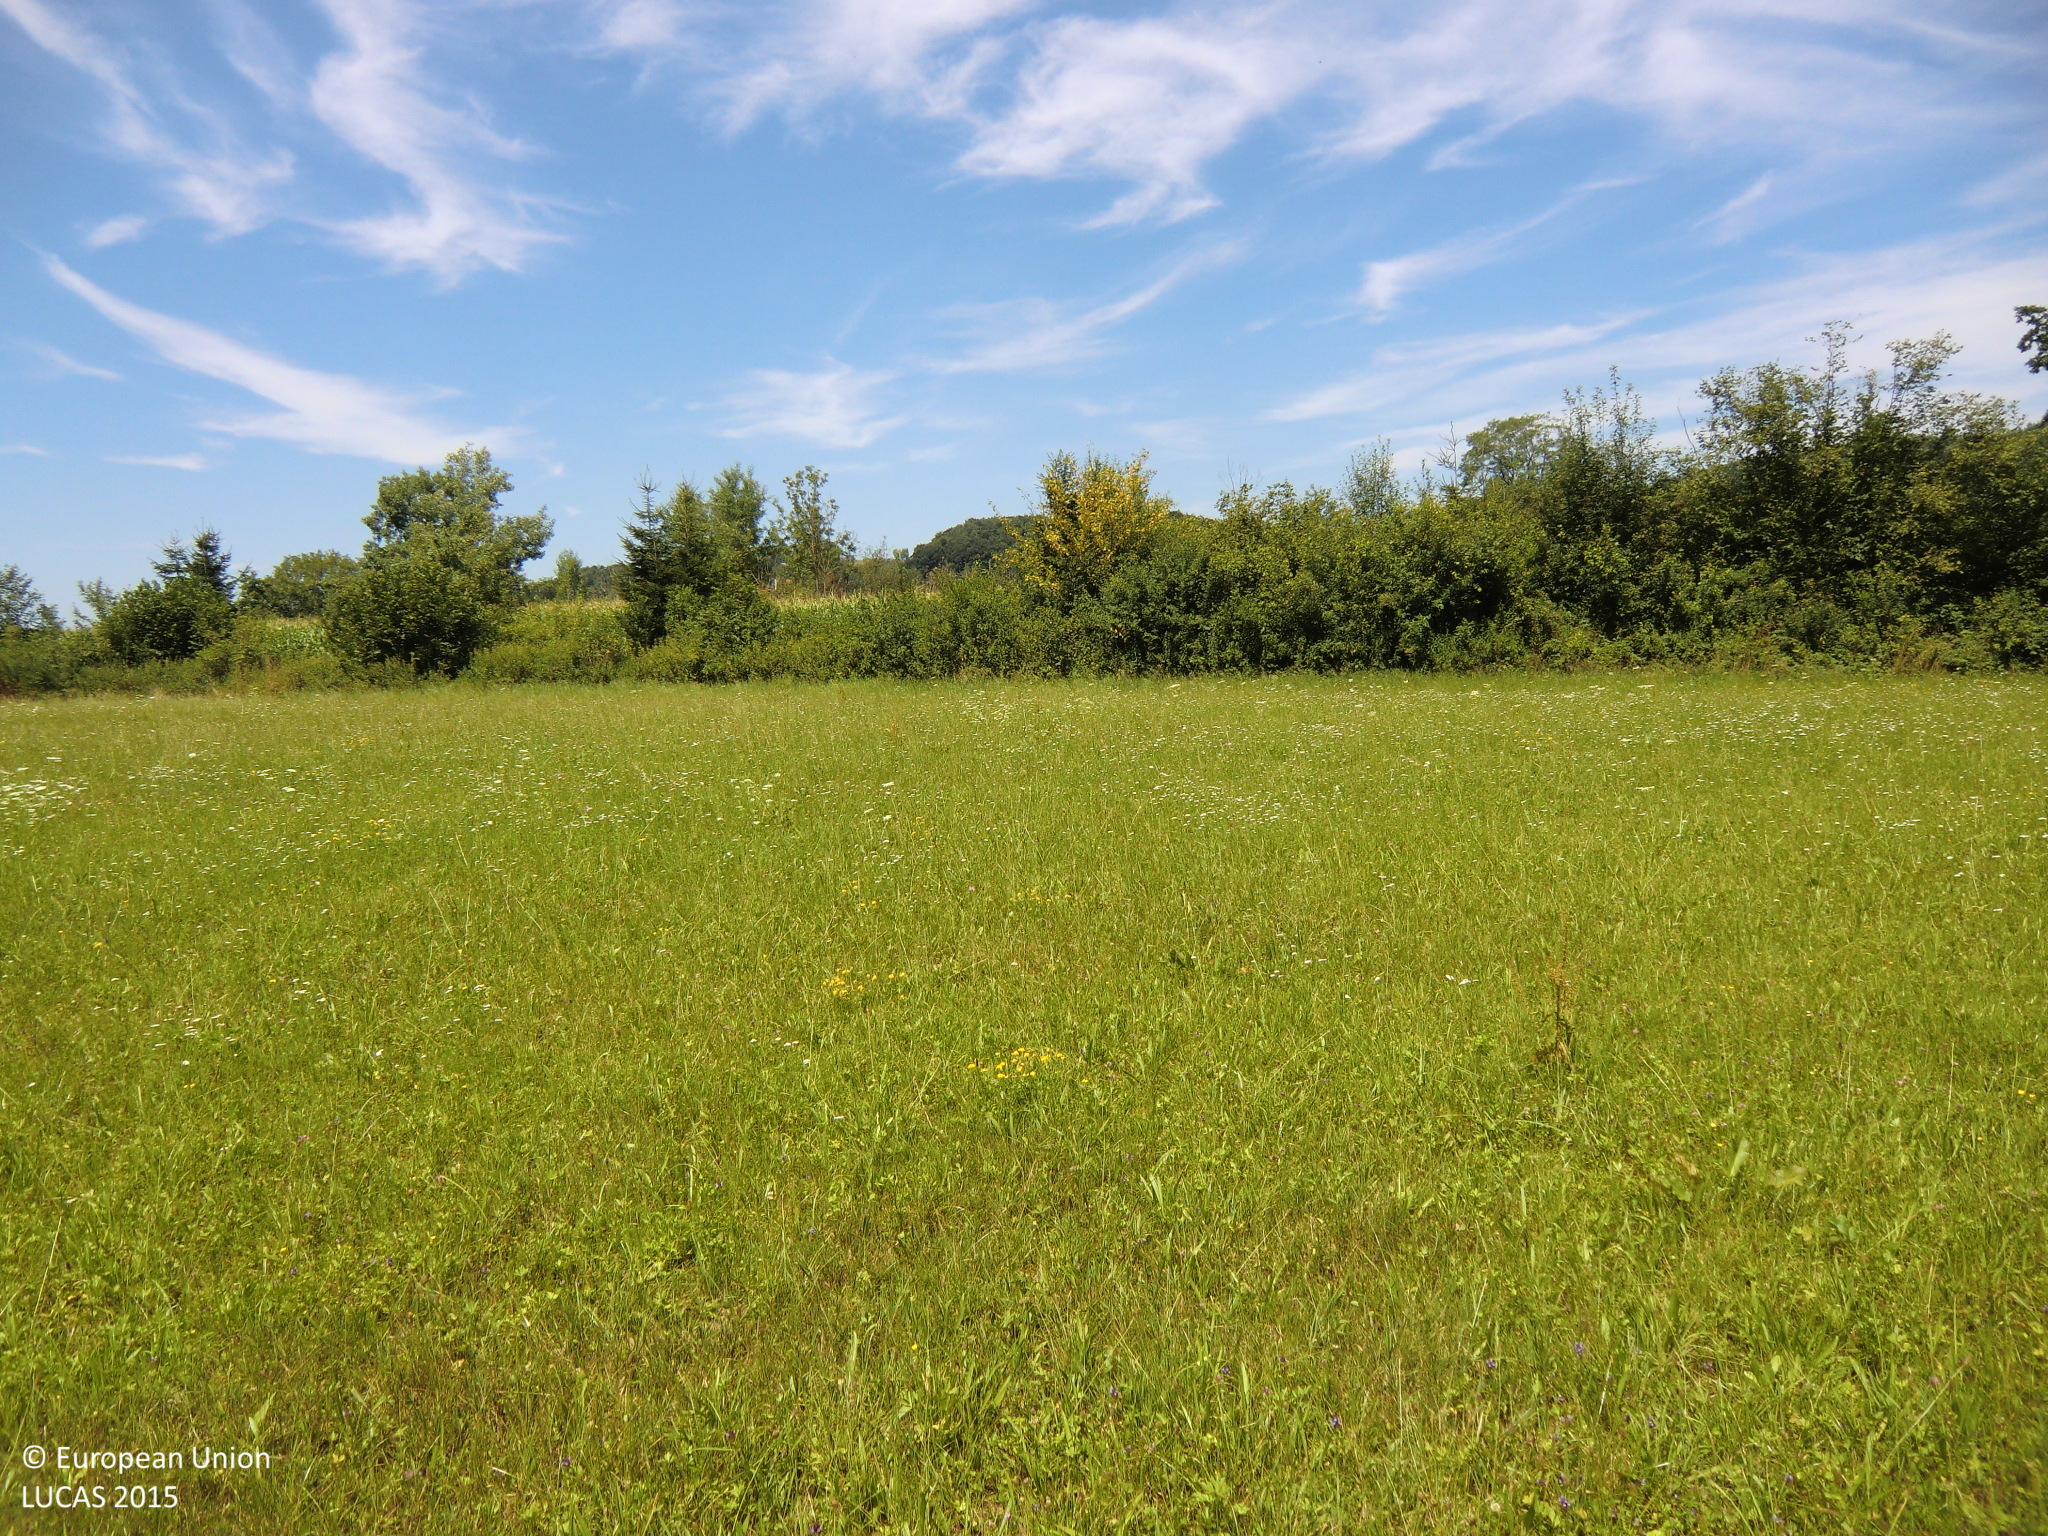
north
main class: Grassland
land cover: Grassland without tree/shrub cover
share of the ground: > 75 %
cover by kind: herbaceous plants 100 %
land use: Agriculture (excluding fallow land and kitchen gardens)
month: July
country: AT
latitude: 47.1042
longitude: 15.6532
